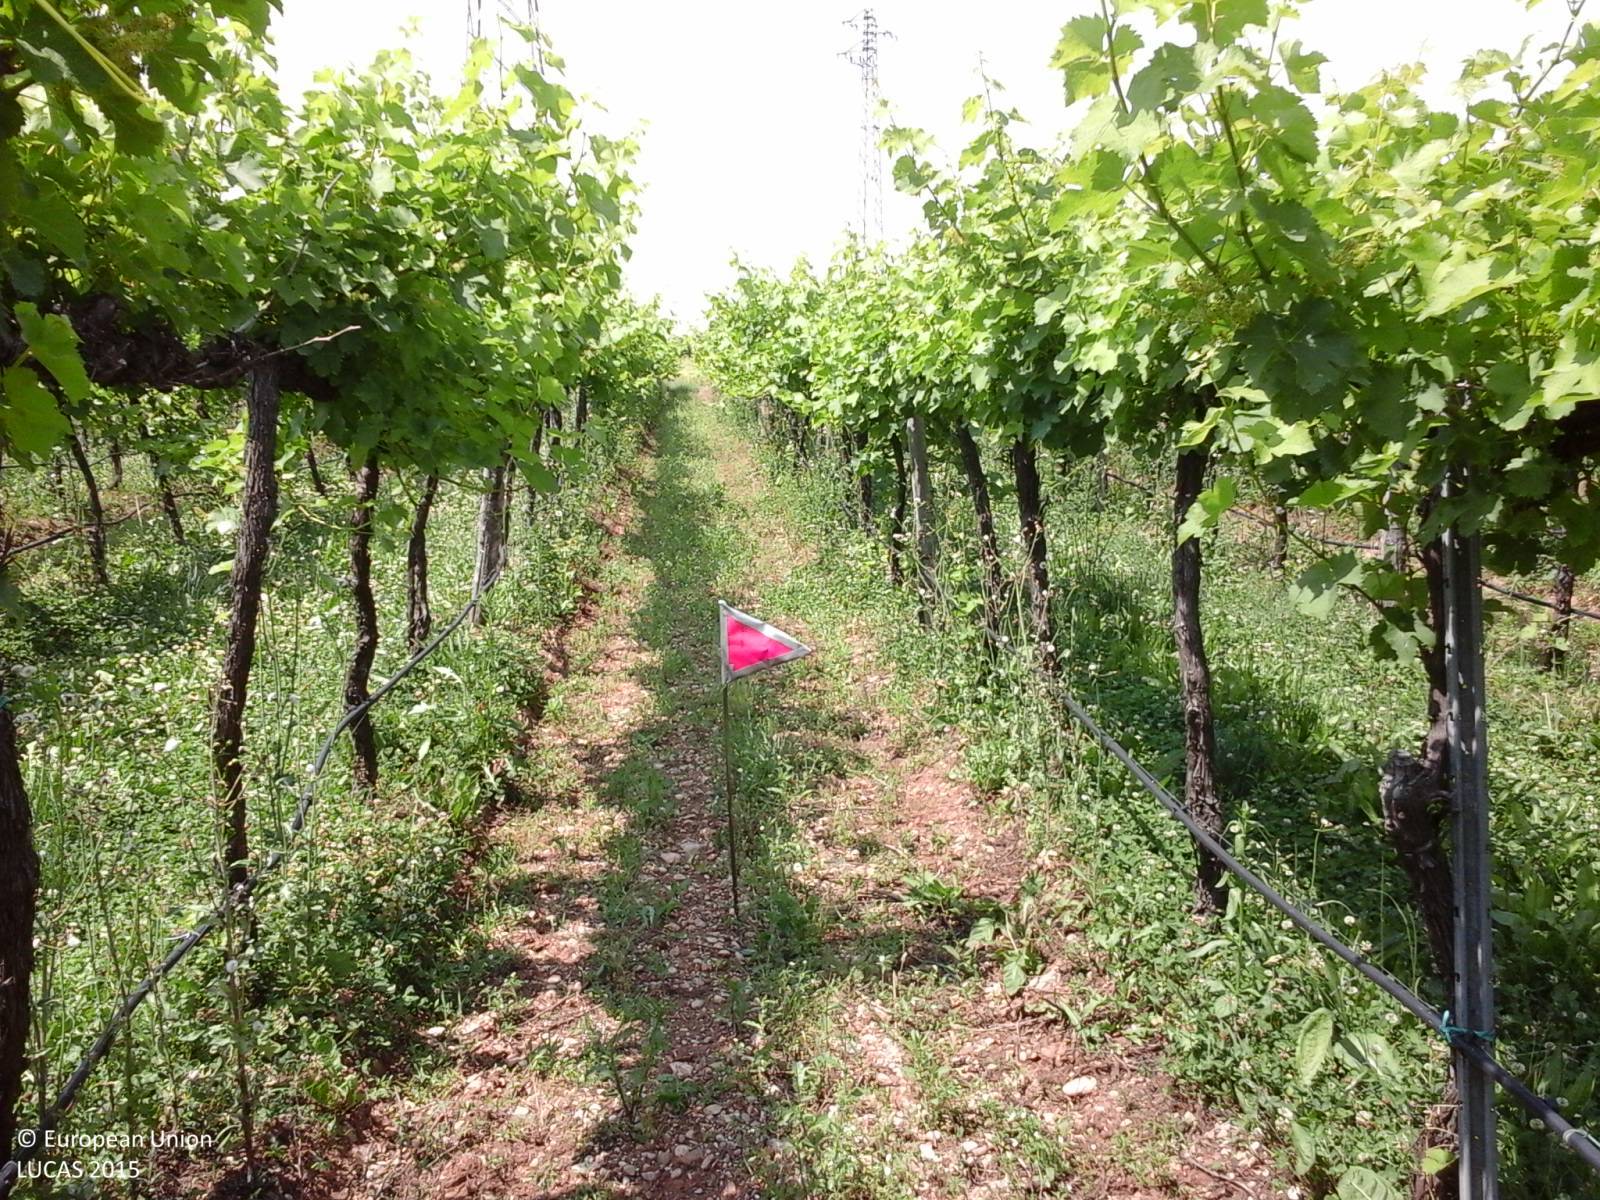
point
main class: Cropland
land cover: Vineyards
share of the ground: > 75 %
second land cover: Grassland without tree/shrub cover
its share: > 75 %
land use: Agriculture (excluding fallow land and kitchen gardens)
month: June
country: IT
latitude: 45.9370
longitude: 13.3883
